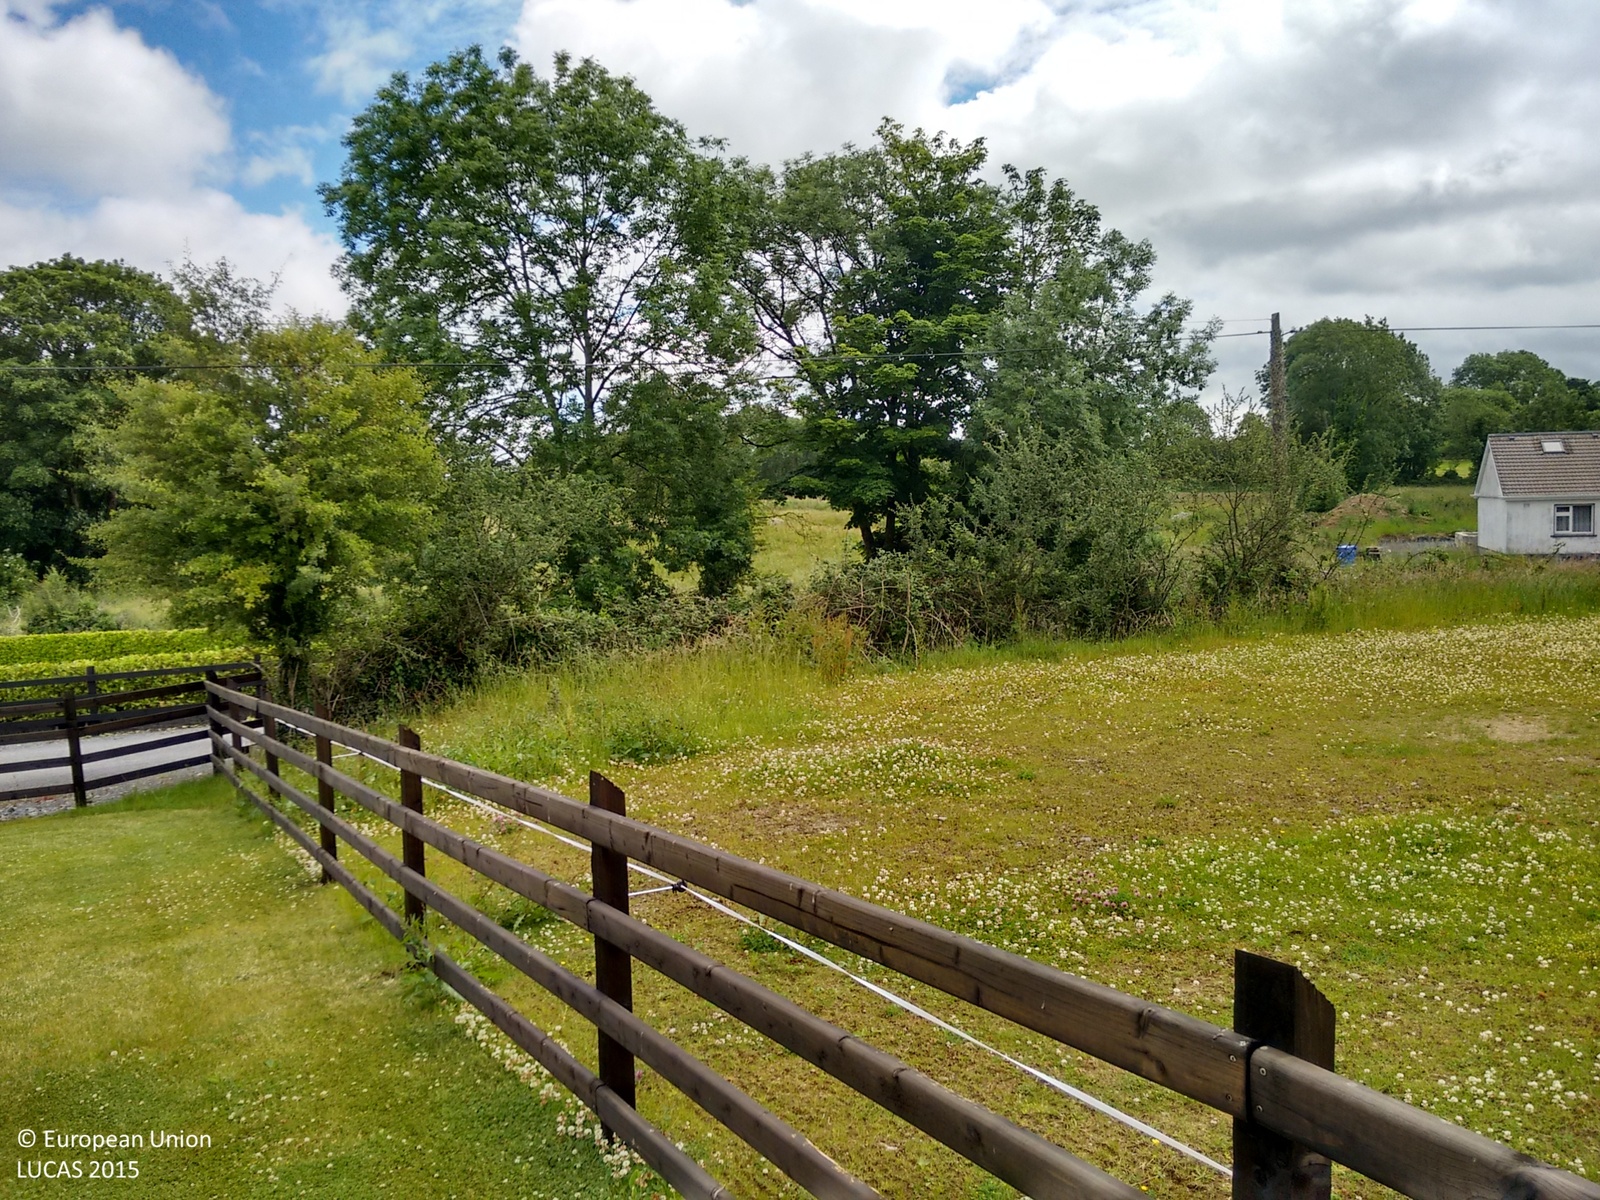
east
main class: Grassland
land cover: Grassland without tree/shrub cover
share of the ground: > 75 %
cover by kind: herbaceous plants 100 %
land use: Agriculture (excluding fallow land and kitchen gardens)
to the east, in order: Grassland without tree/shrub cover; Spontaneously vegetated surfaces; Abandoned hedges; Fences; Electric lines; Paved roads, cycling and walking lanes; Broadleaved woodland; Dry stone walls; Broadleaved woodland; Grassland without tree/shrub cover; Fences; Other bare soil; Broadleaved woodland; Dry stone walls; Fences; Broadleaved woodland; Grassland without tree/shrub cover
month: June
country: IE
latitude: 53.4368
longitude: -8.0136
